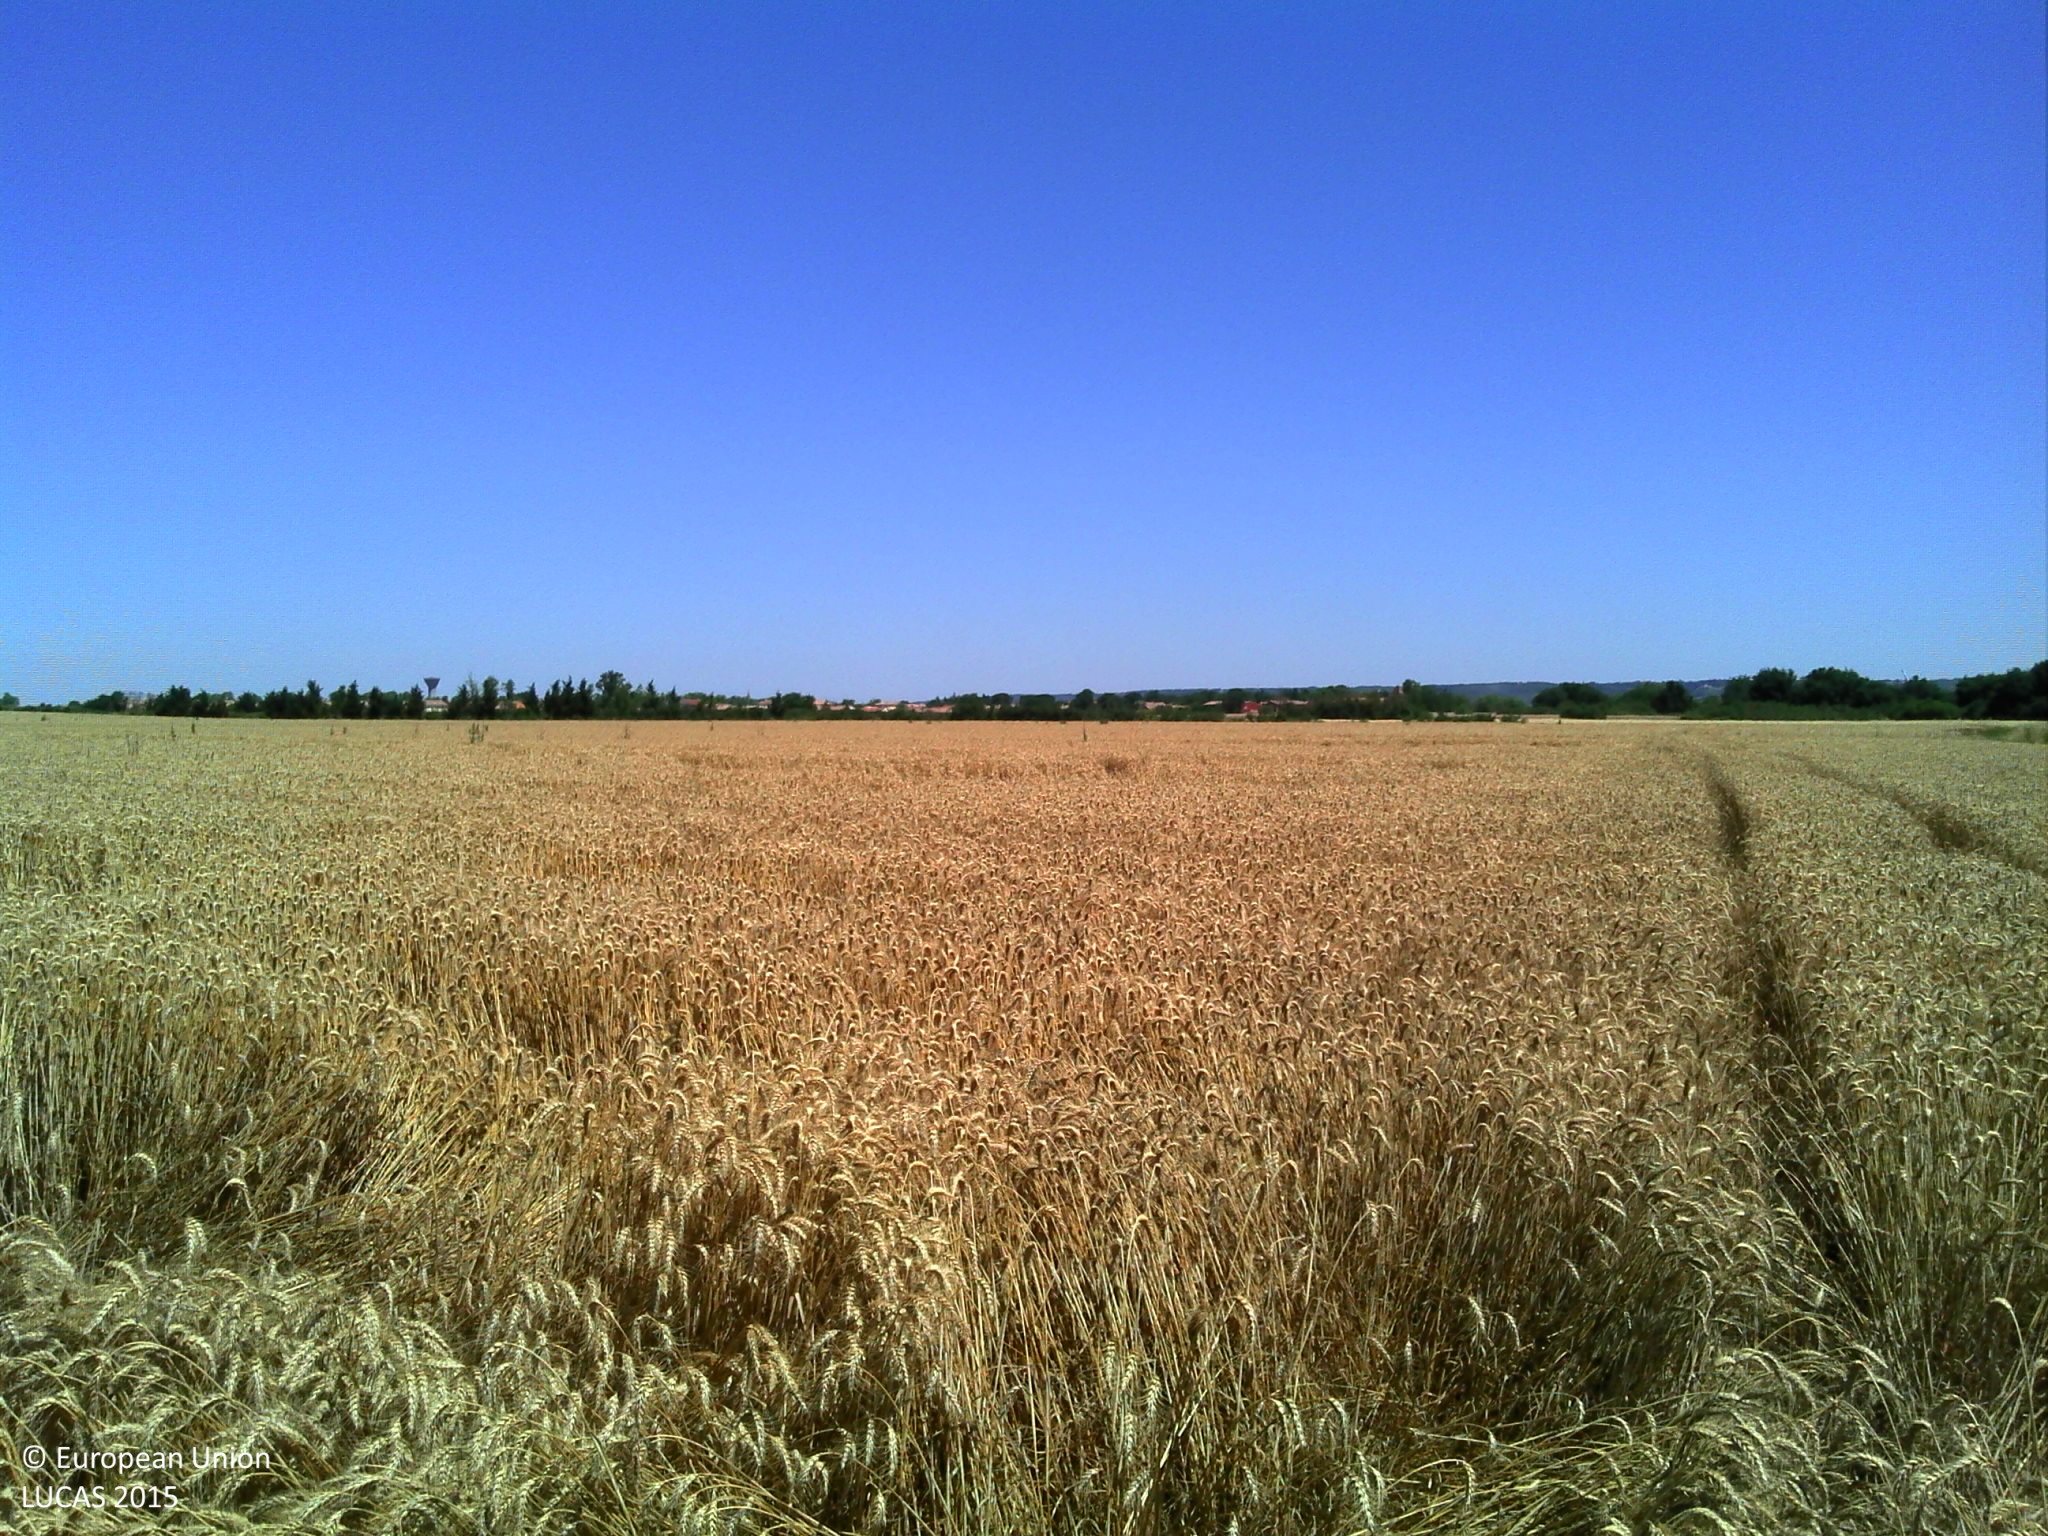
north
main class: Cropland
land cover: Durum wheat
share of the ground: > 75 %
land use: Agriculture (excluding fallow land and kitchen gardens)
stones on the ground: < 10 %
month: June
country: FR
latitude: 43.7485
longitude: 1.2957
